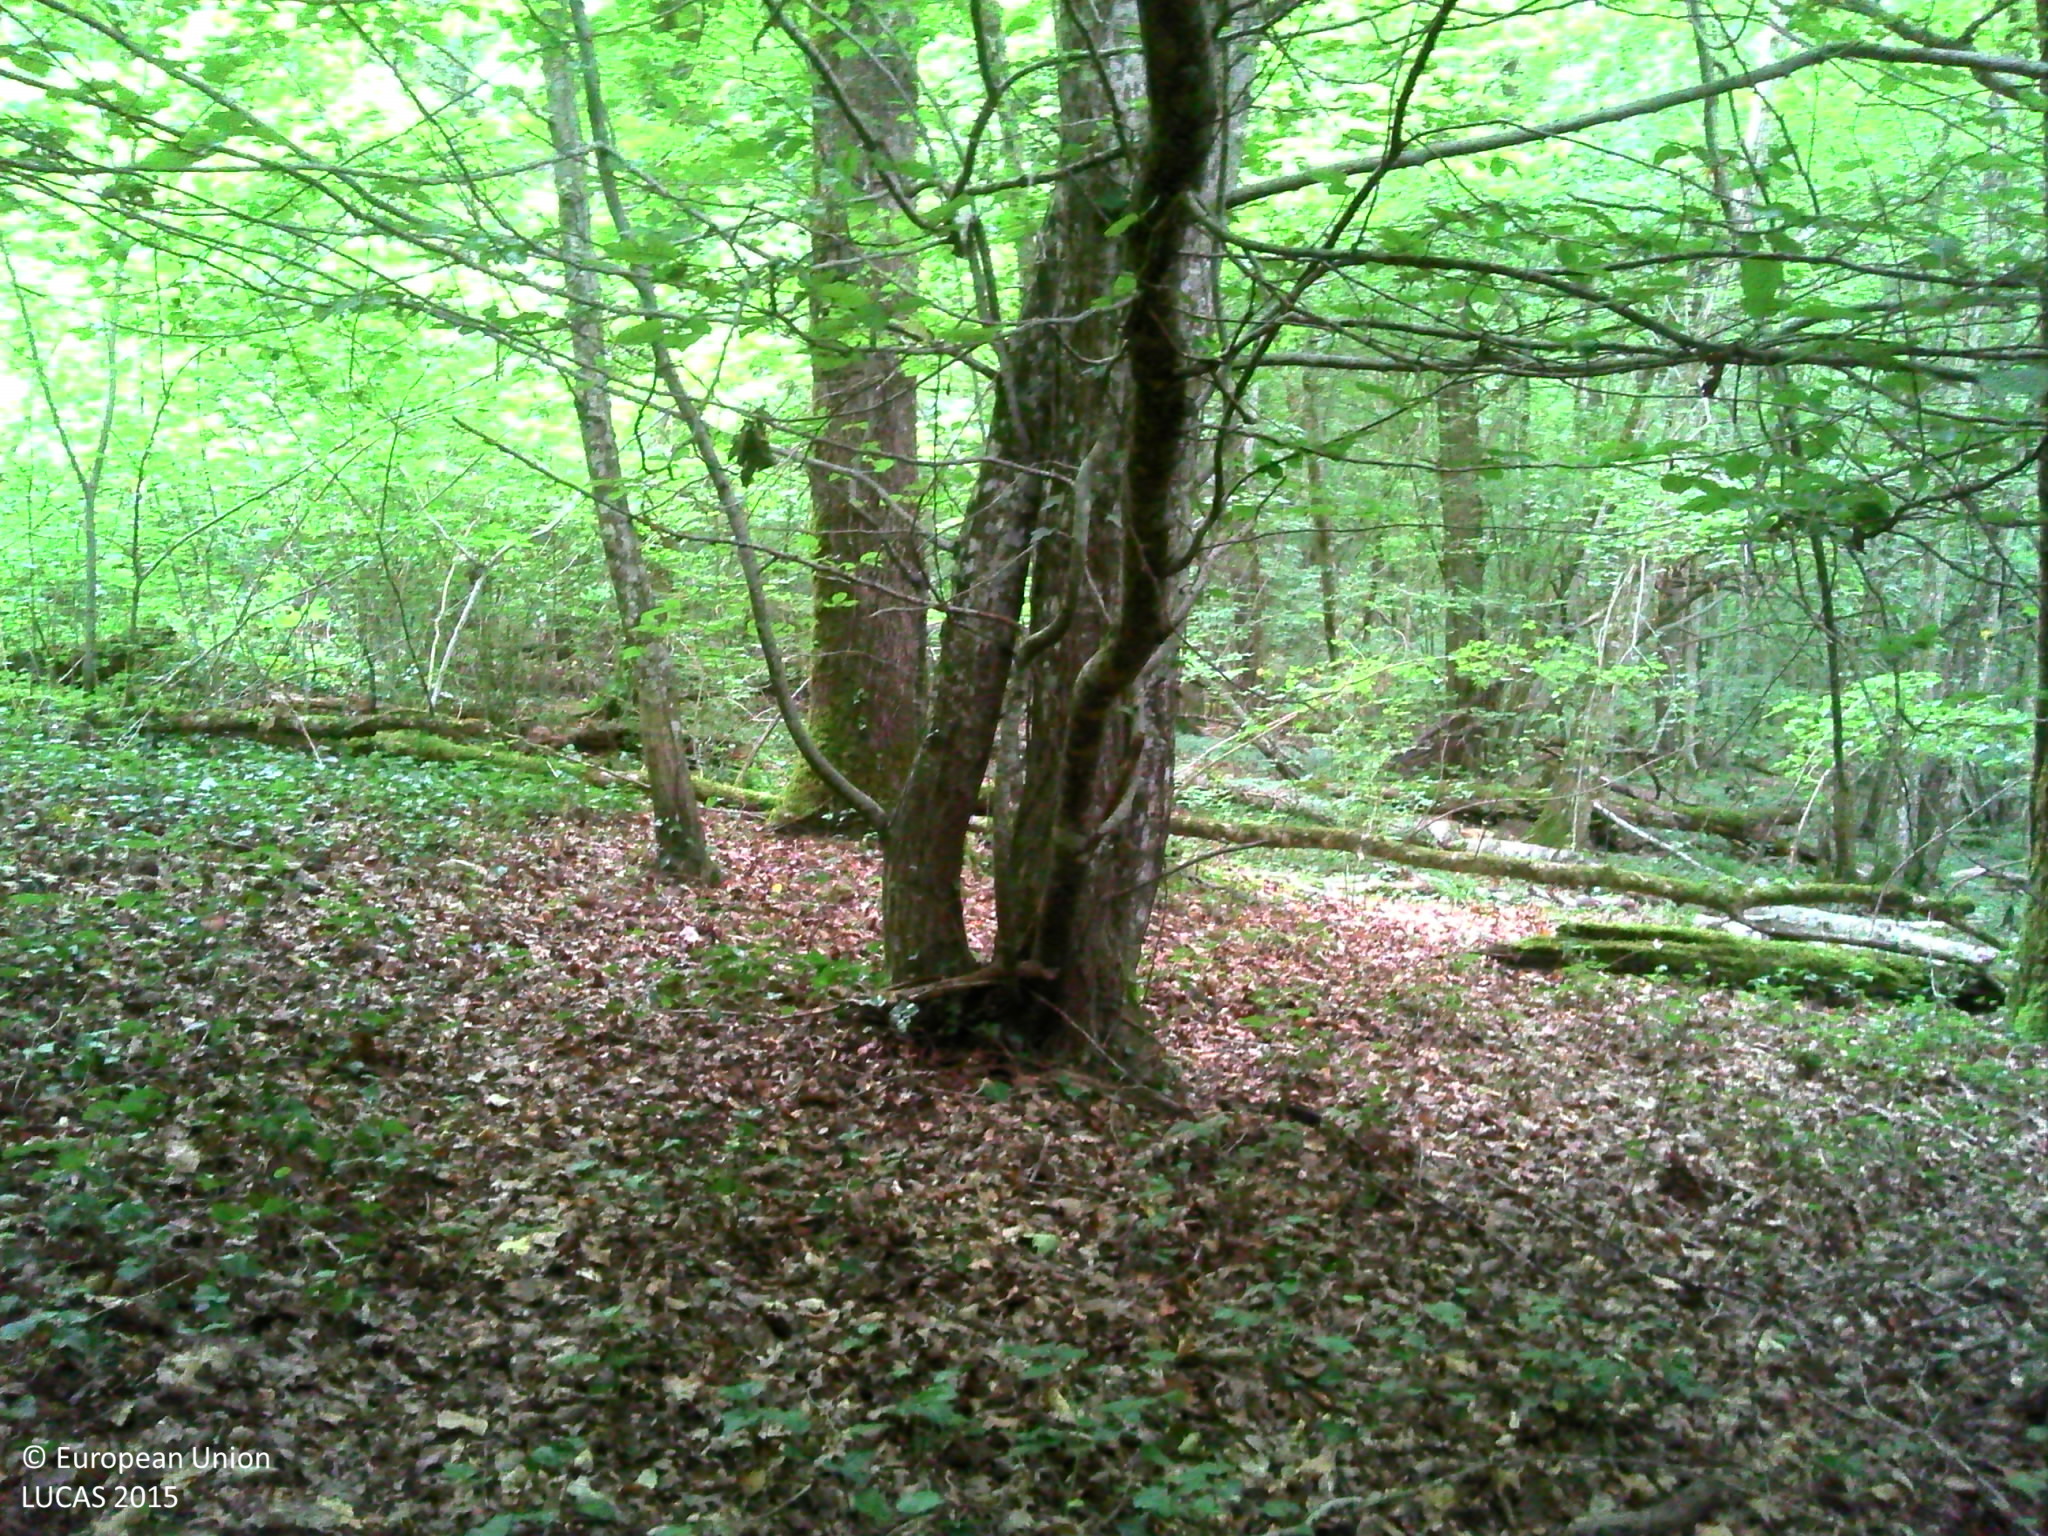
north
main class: Woodland
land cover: Broadleaved woodland
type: mesophytic deciduous forest
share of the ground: > 75 %
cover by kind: broadleaved forest trees 90 %, herbaceous plants 5 %, lichens and mosses 5 %
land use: Forestry
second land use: Amenities, museums, leisure
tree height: > 5 m
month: June
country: FR
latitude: 48.2835
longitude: 3.4852
